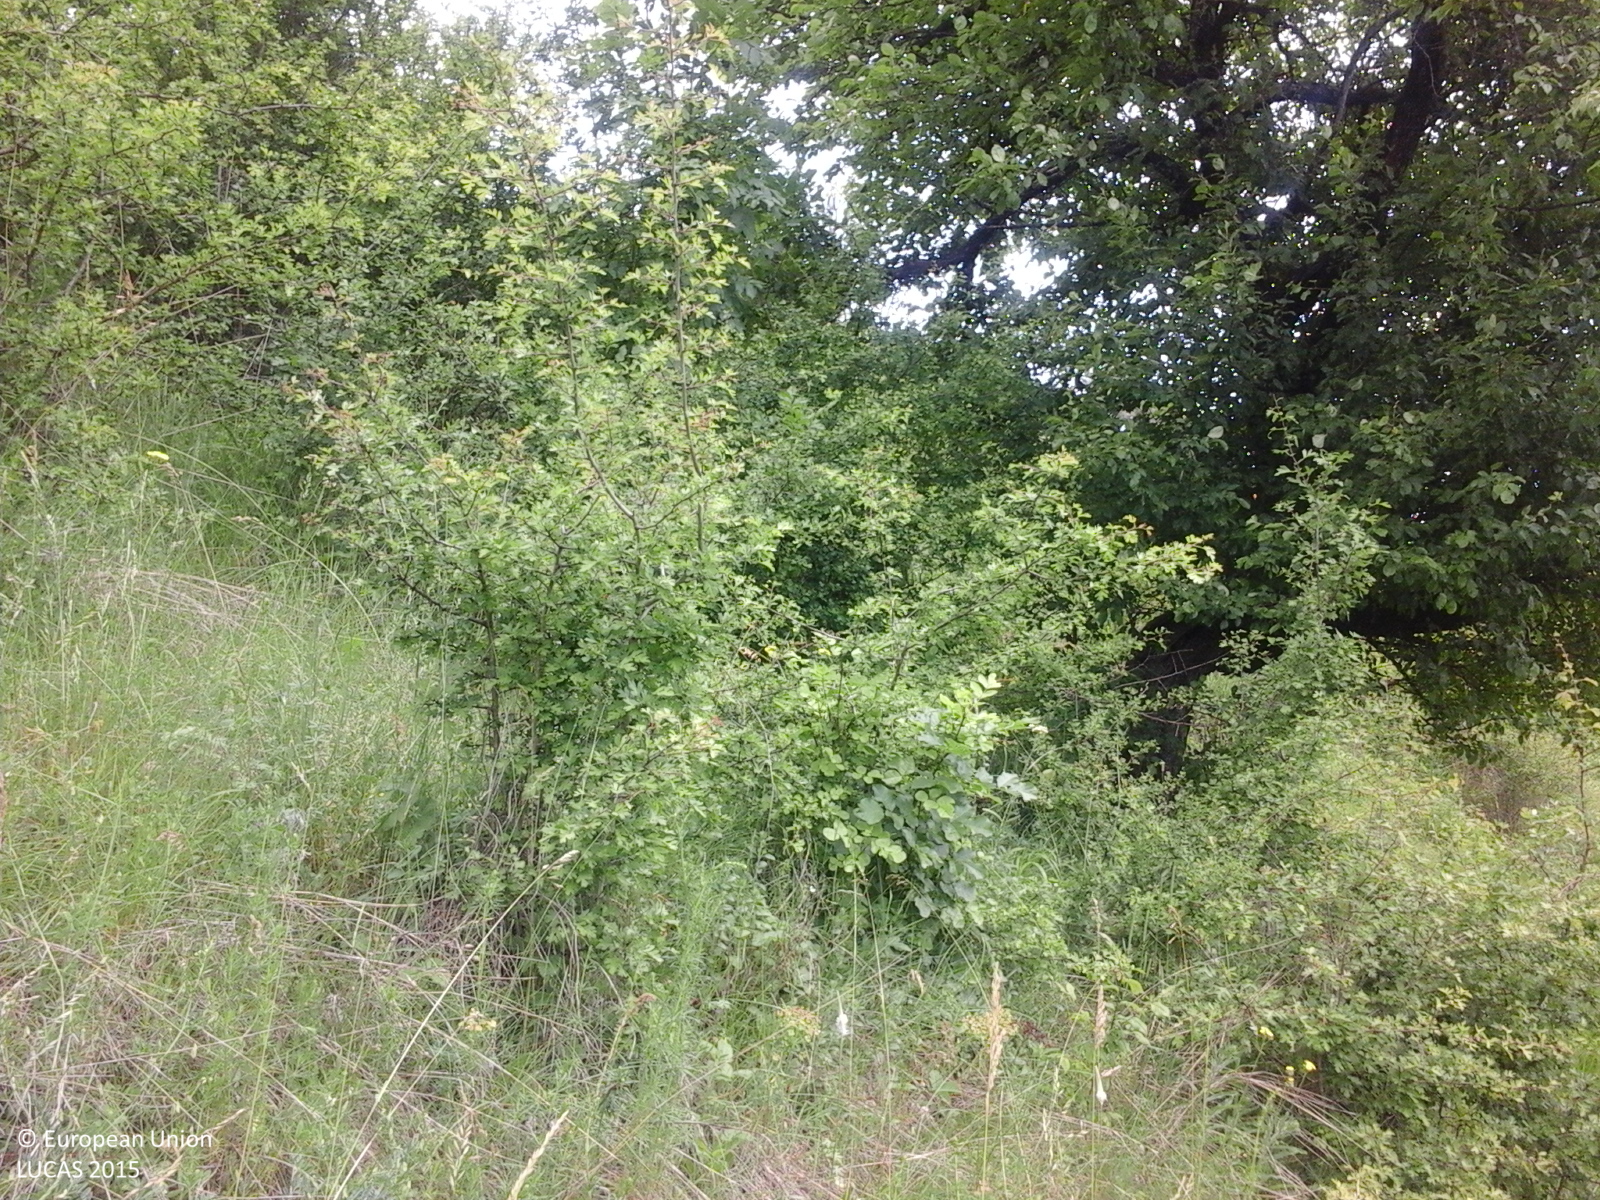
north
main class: Grassland
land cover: Grassland with sparse tree/shrub cover
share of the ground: > 75 %
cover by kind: herbaceous plants 90 %, broadleaved forest trees 5 %, shrubs 5 %
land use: Agriculture (excluding fallow land and kitchen gardens)
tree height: < 5 m
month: May
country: RO
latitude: 45.2650
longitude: 26.2387
